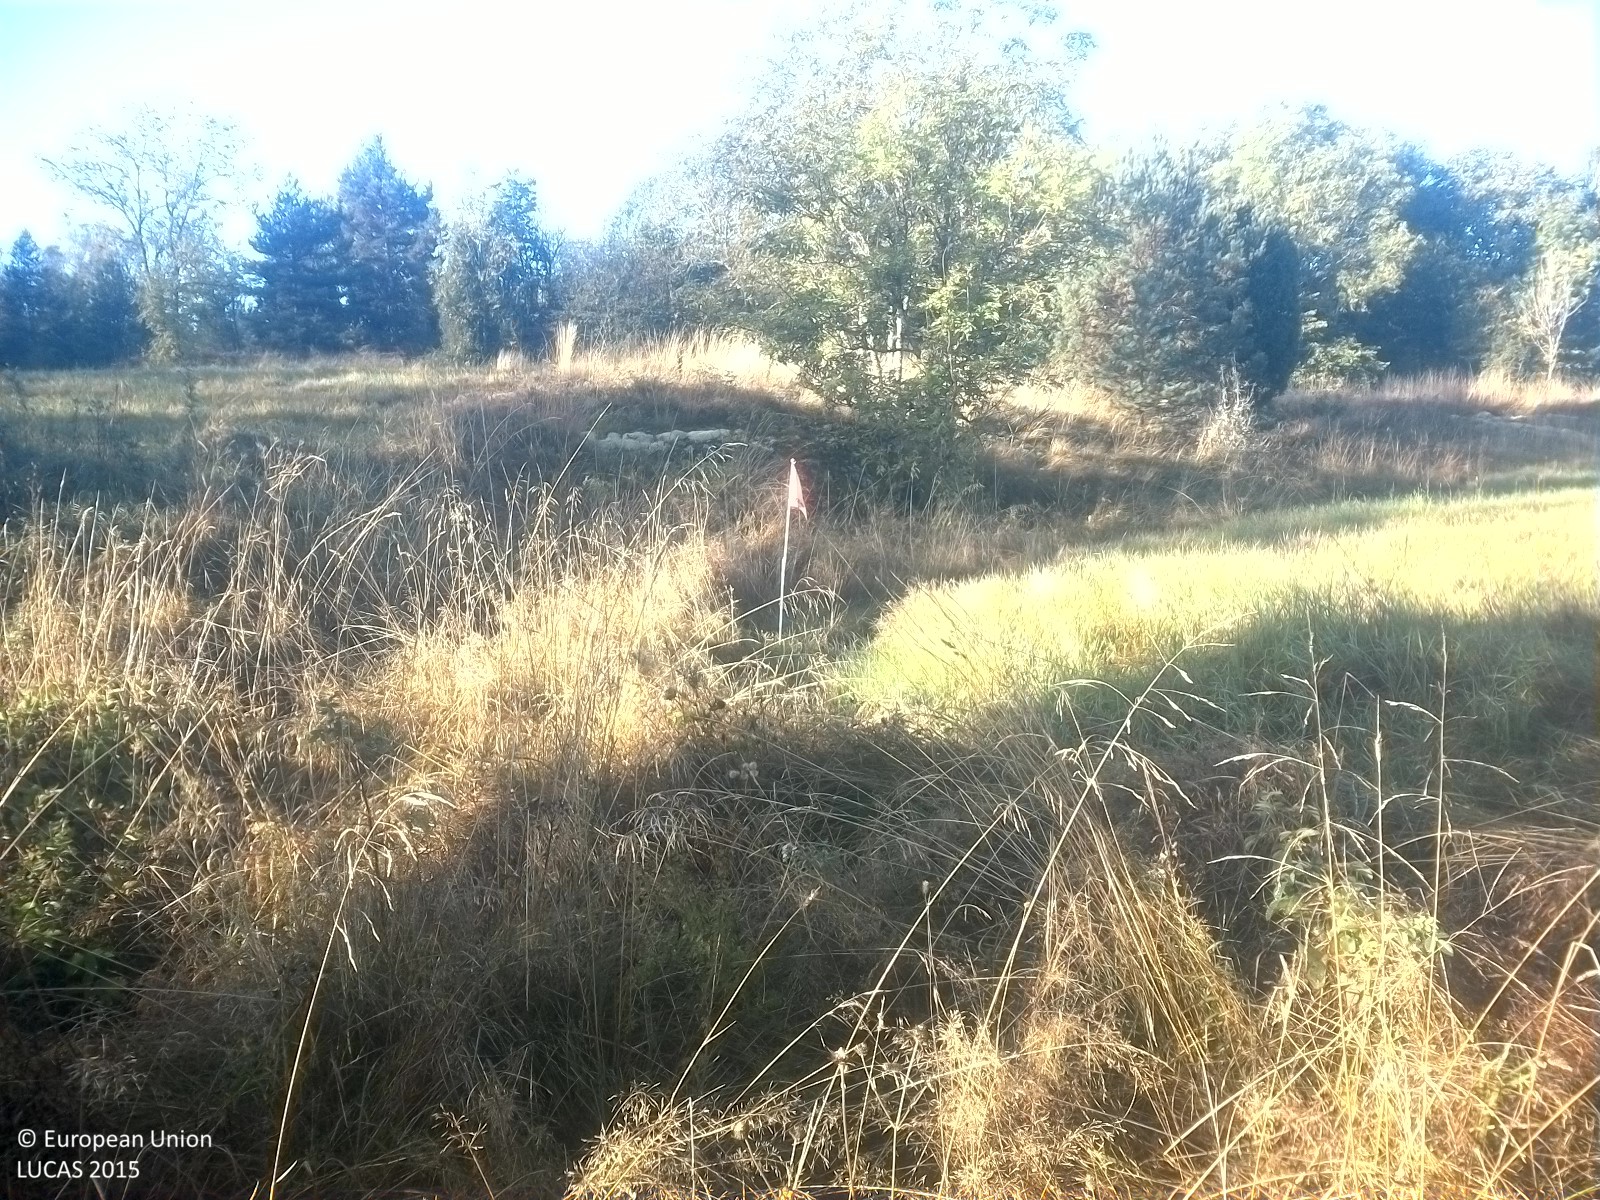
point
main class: Grassland
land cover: Grassland without tree/shrub cover
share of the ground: > 75 %
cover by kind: herbaceous plants 100 %
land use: Agriculture (excluding fallow land and kitchen gardens)
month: September
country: SE
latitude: 58.4840
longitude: 16.7373
